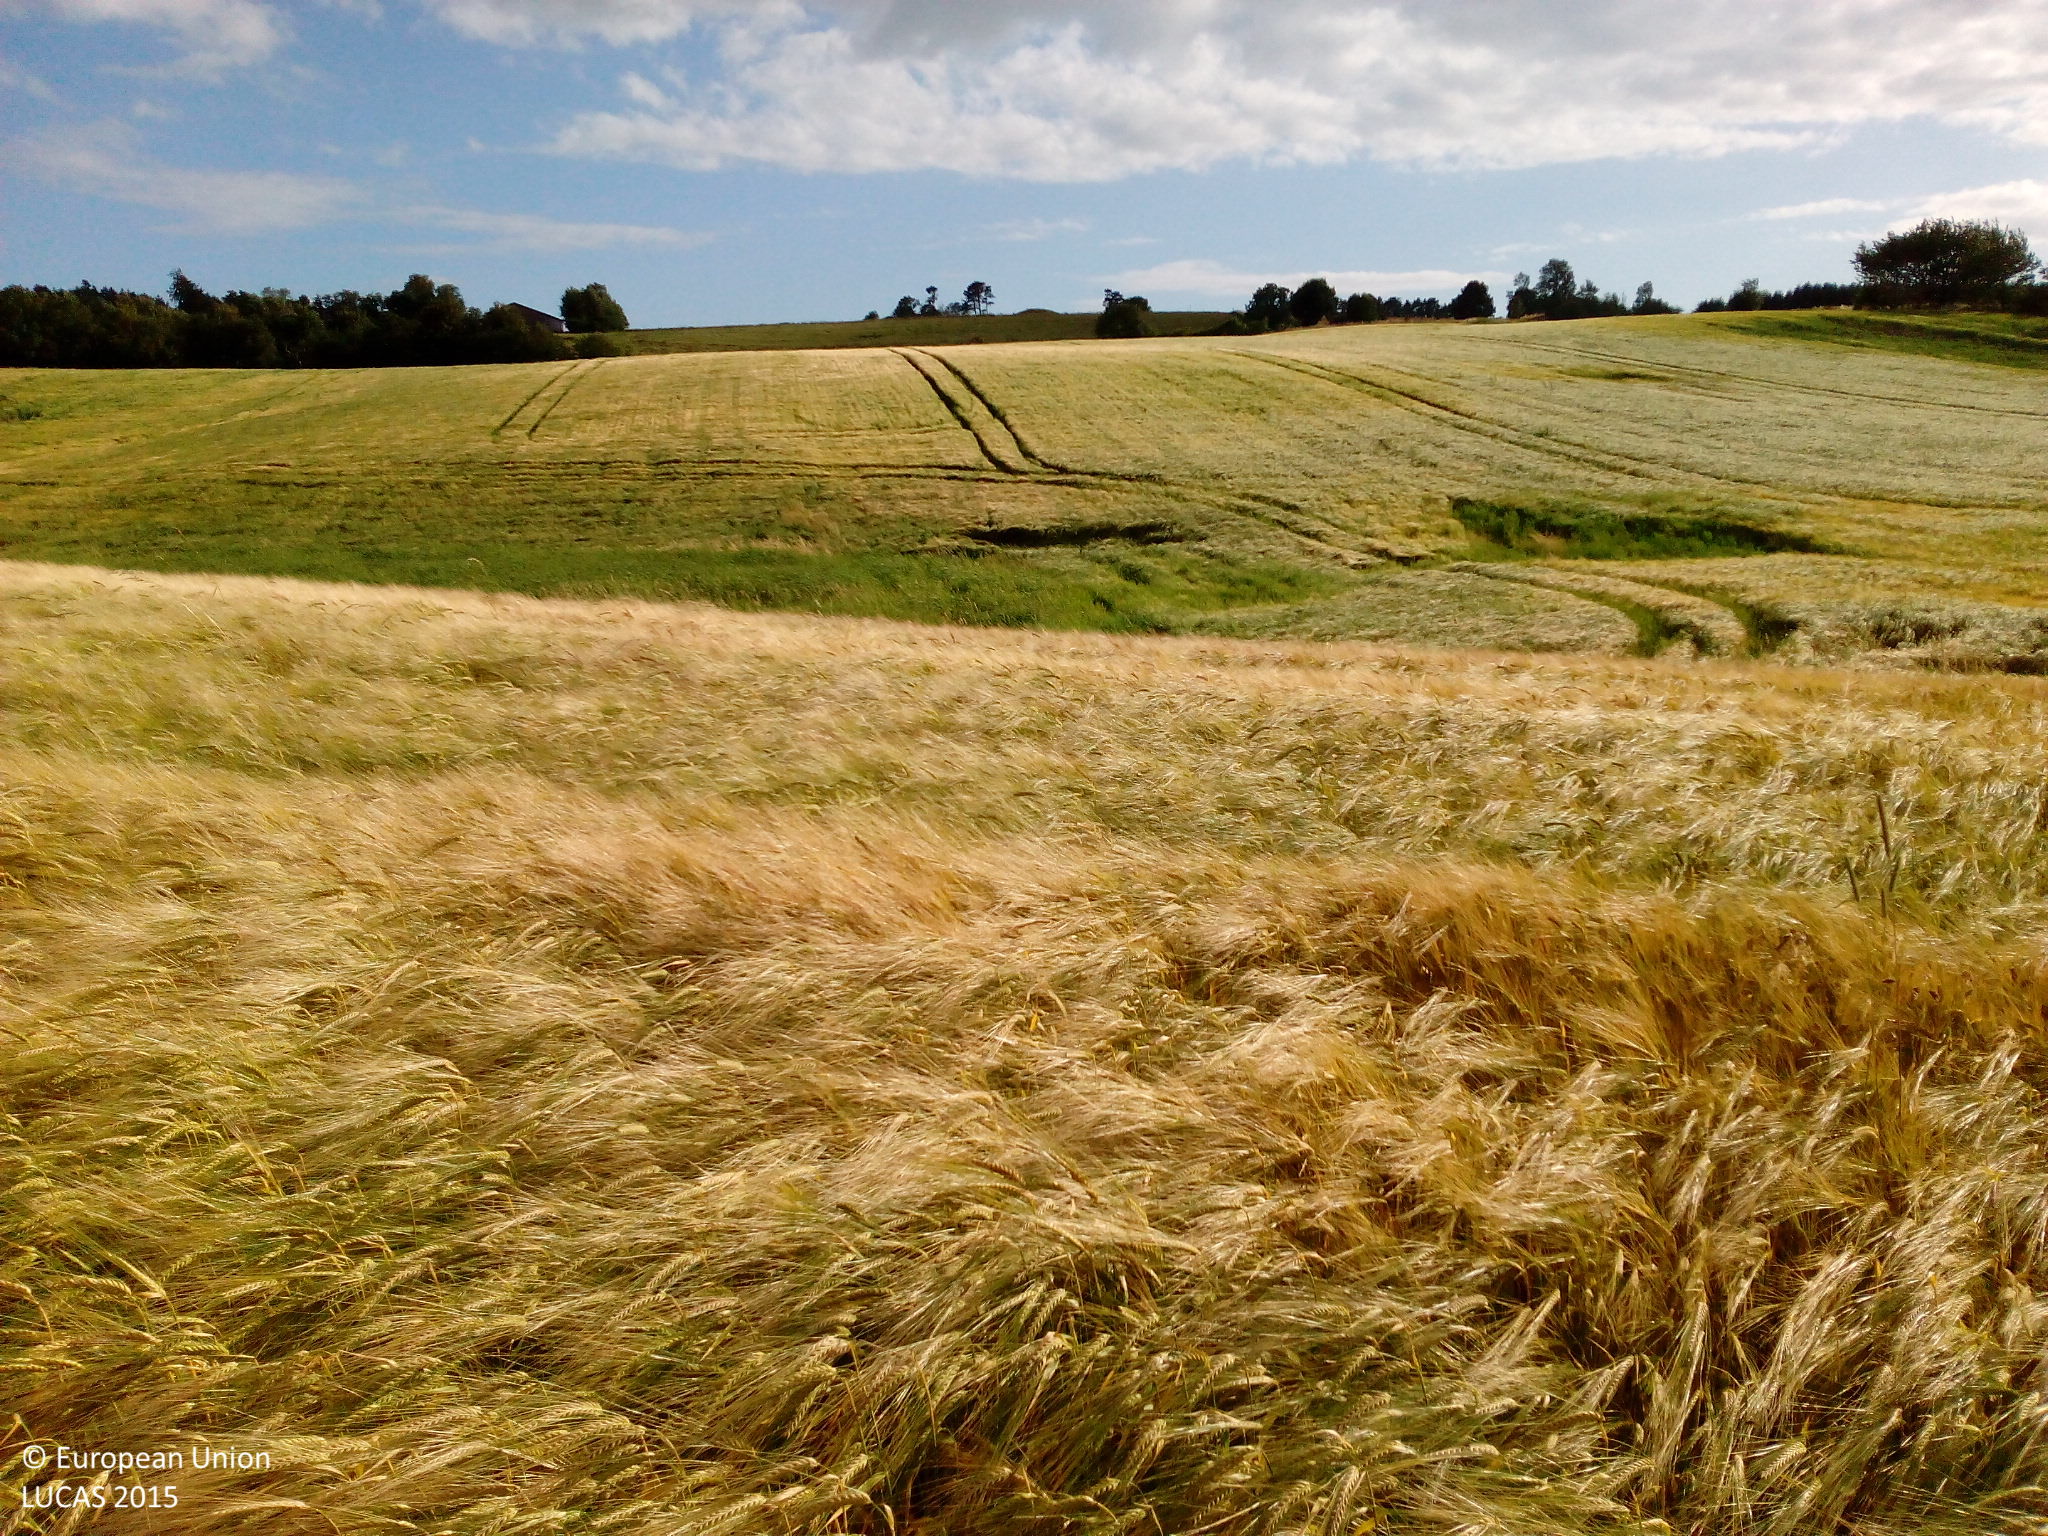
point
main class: Cropland
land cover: Barley
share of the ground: > 75 %
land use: Agriculture (excluding fallow land and kitchen gardens)
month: July
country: DK
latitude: 55.8372
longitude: 11.5154
